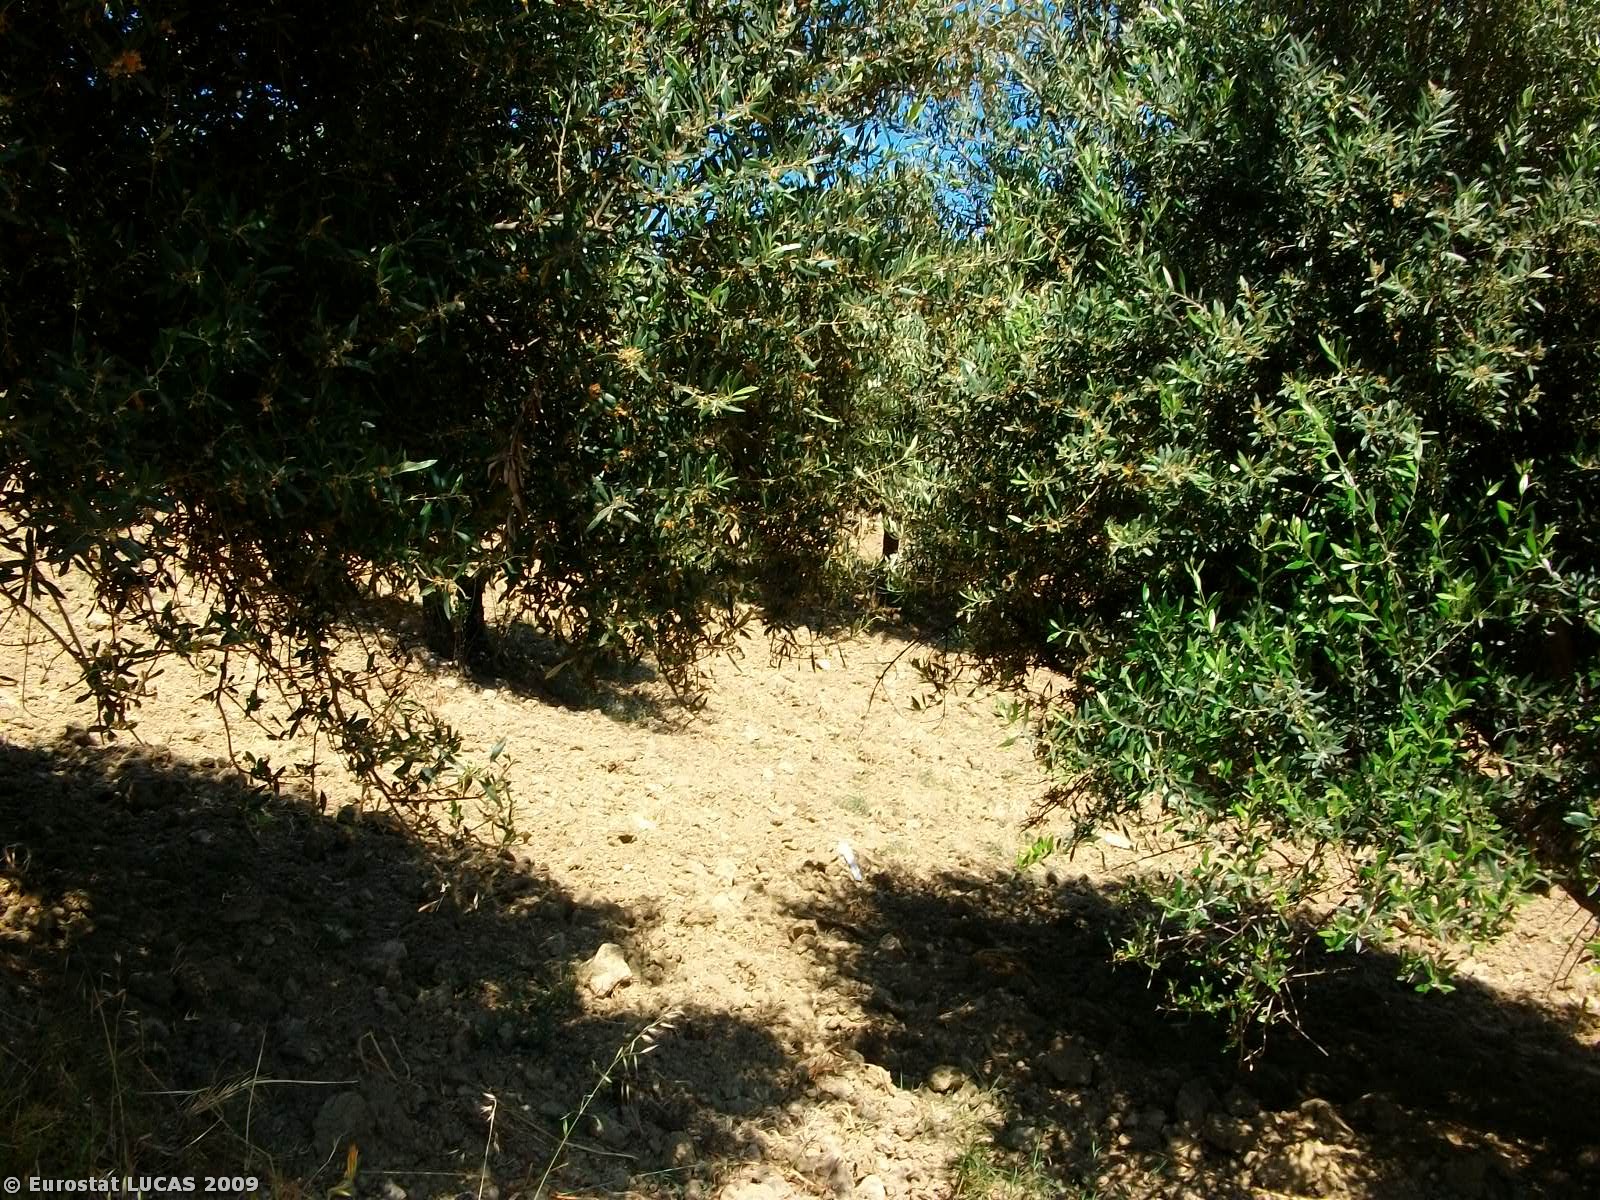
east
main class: Cropland
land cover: Olive groves
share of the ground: 50 - 75 %
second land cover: Bare land
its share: > 75 %
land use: Agriculture (excluding fallow land and kitchen gardens)
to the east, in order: Olive groves; Bare land; Shrubland with sparse tree cover; Olive groves; Shrubland with sparse tree cover
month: June
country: GR
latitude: 35.0833
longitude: 24.9574
